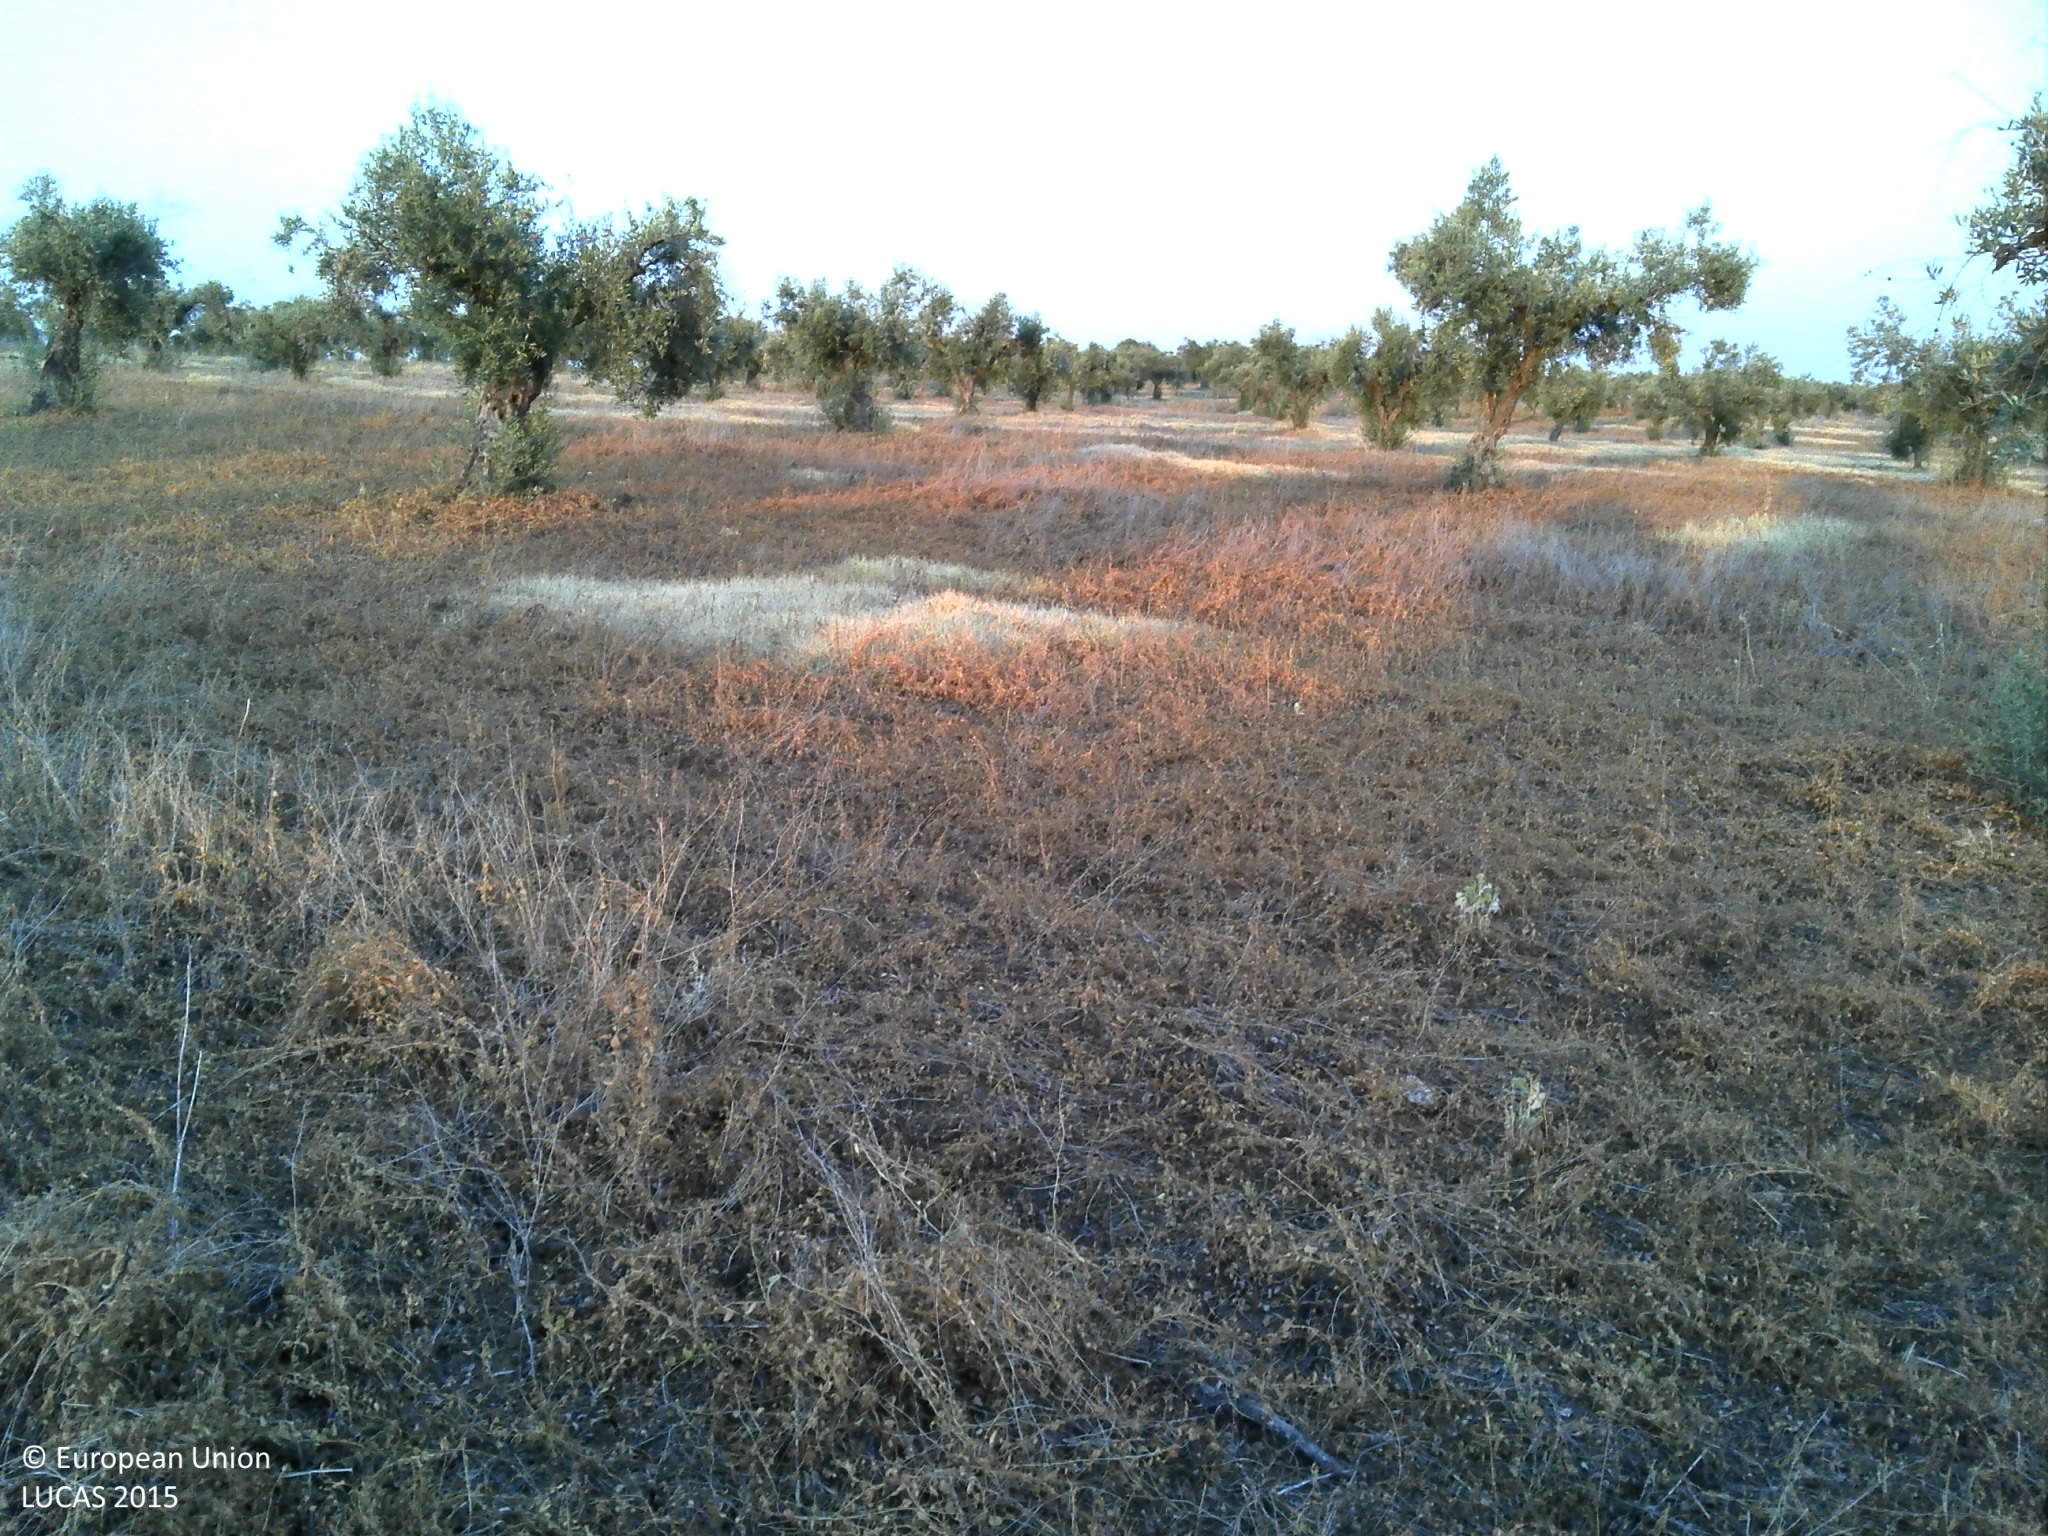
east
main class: Cropland
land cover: Olive groves
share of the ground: 25 - 50 %
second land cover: Grassland without tree/shrub cover
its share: 50 - 75 %
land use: Agriculture (excluding fallow land and kitchen gardens)
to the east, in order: Olive groves; Grassland without tree/shrub cover; Olive groves; Other structural elements; Fences; Olive groves; Tracks; Olive groves
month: June
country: PT
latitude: 38.2891
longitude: -7.3188
